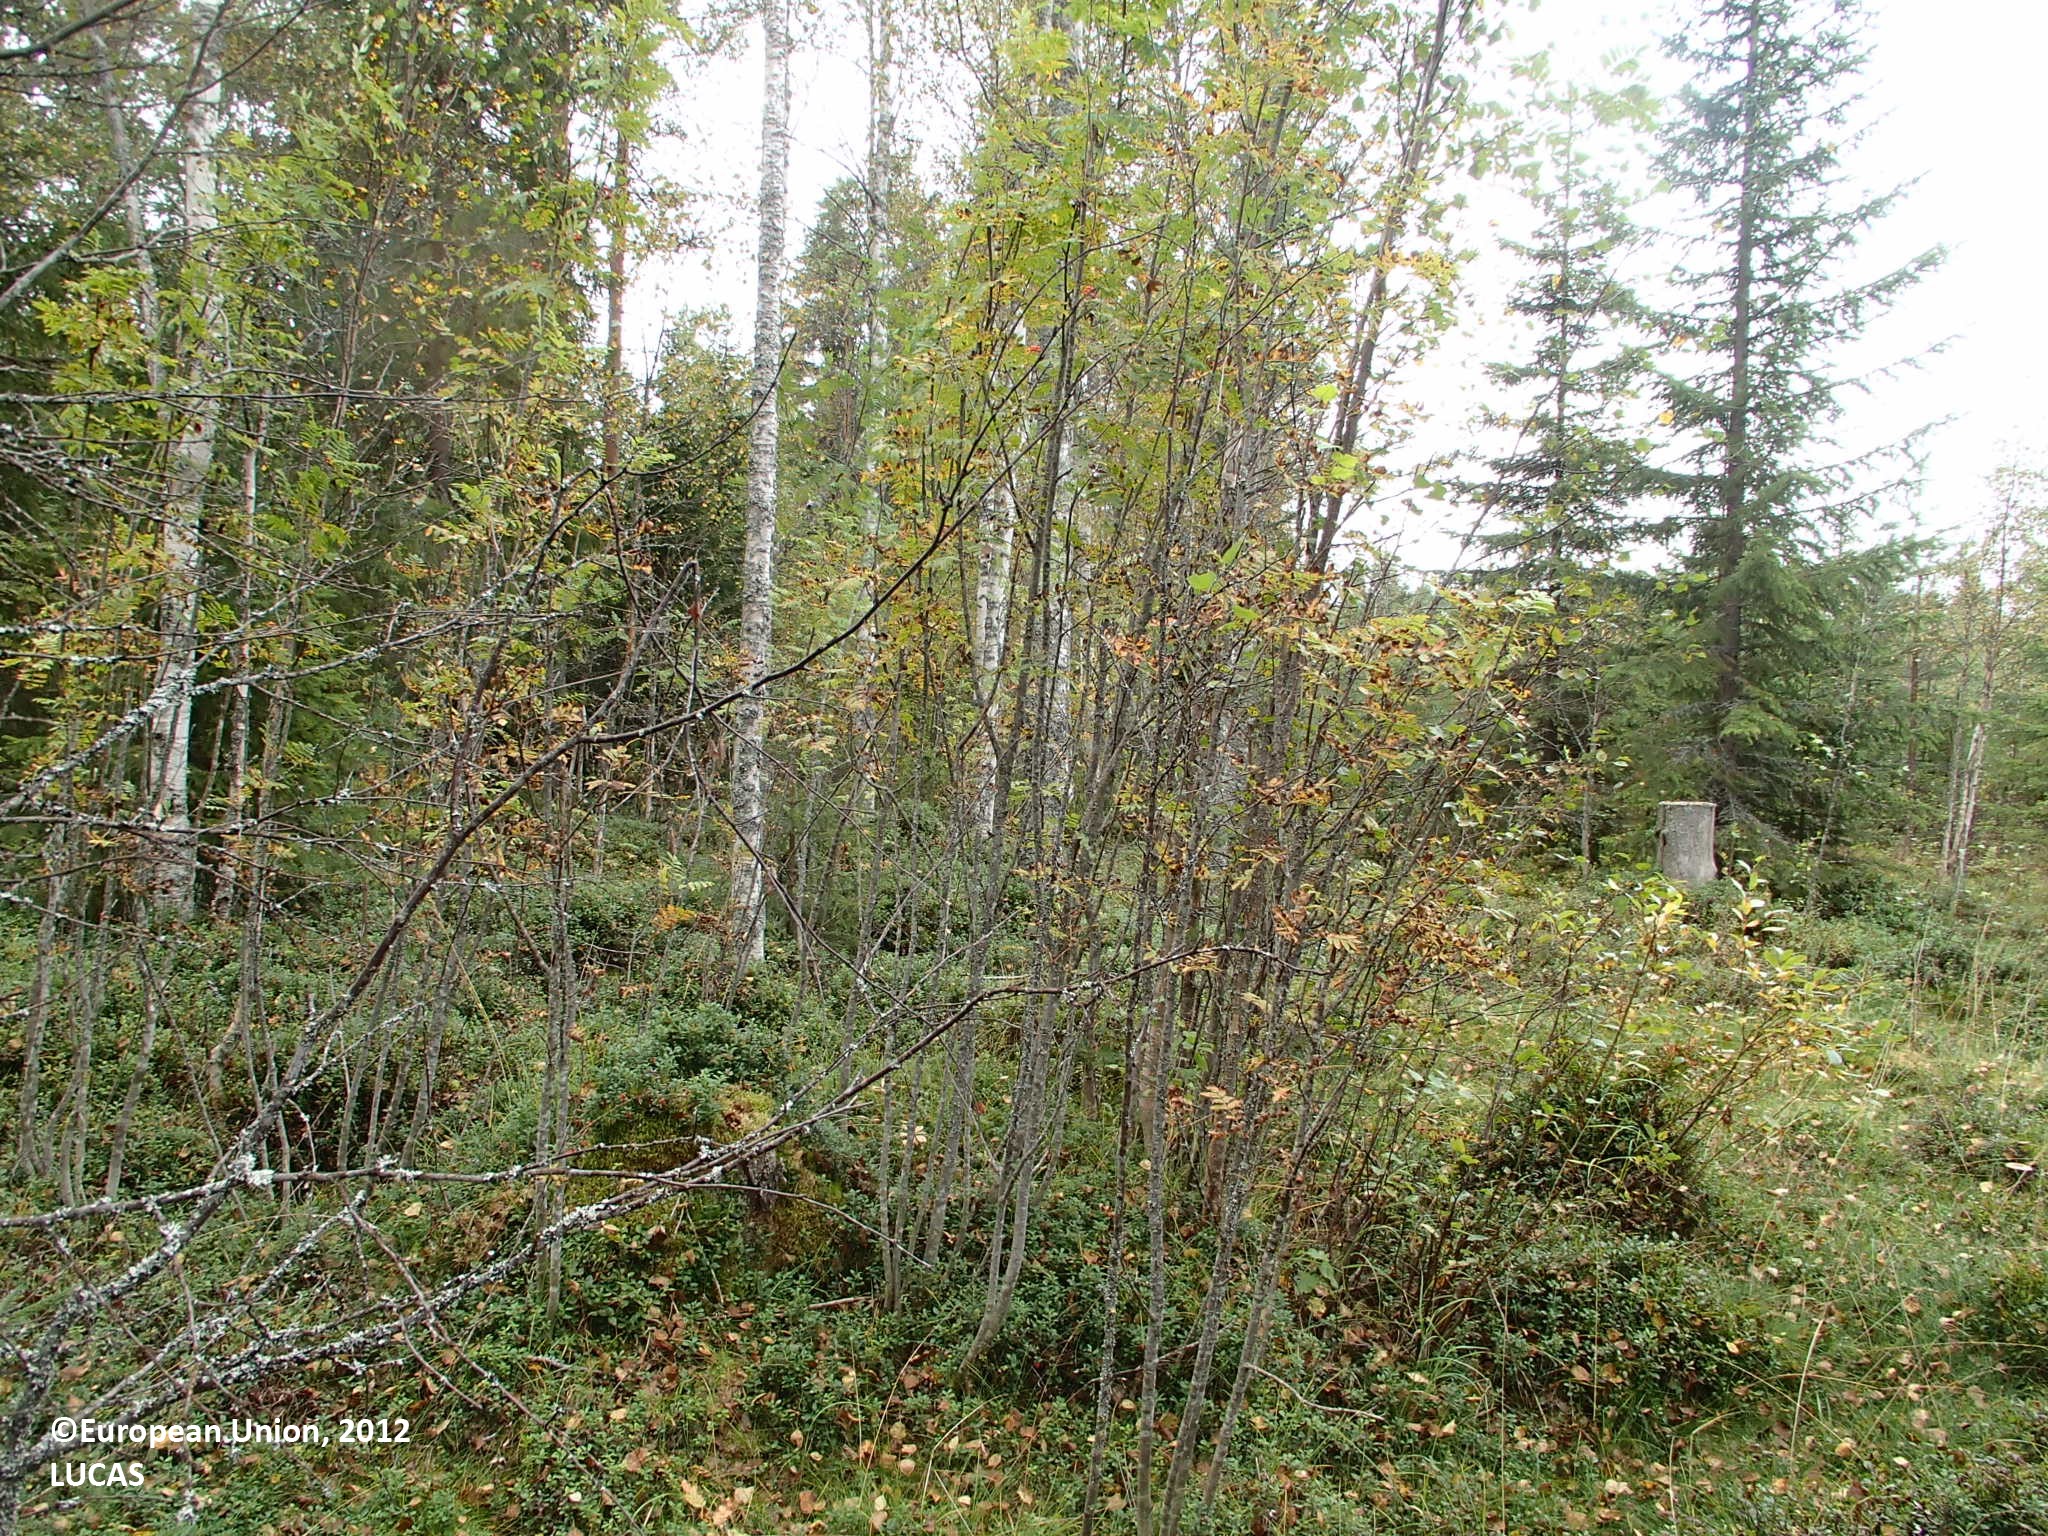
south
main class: Woodland
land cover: Other mixed woodland
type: boreal forest
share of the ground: > 75 %
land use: Forestry
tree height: > 5 m
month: September
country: FI
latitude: 63.8214
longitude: 25.9763
